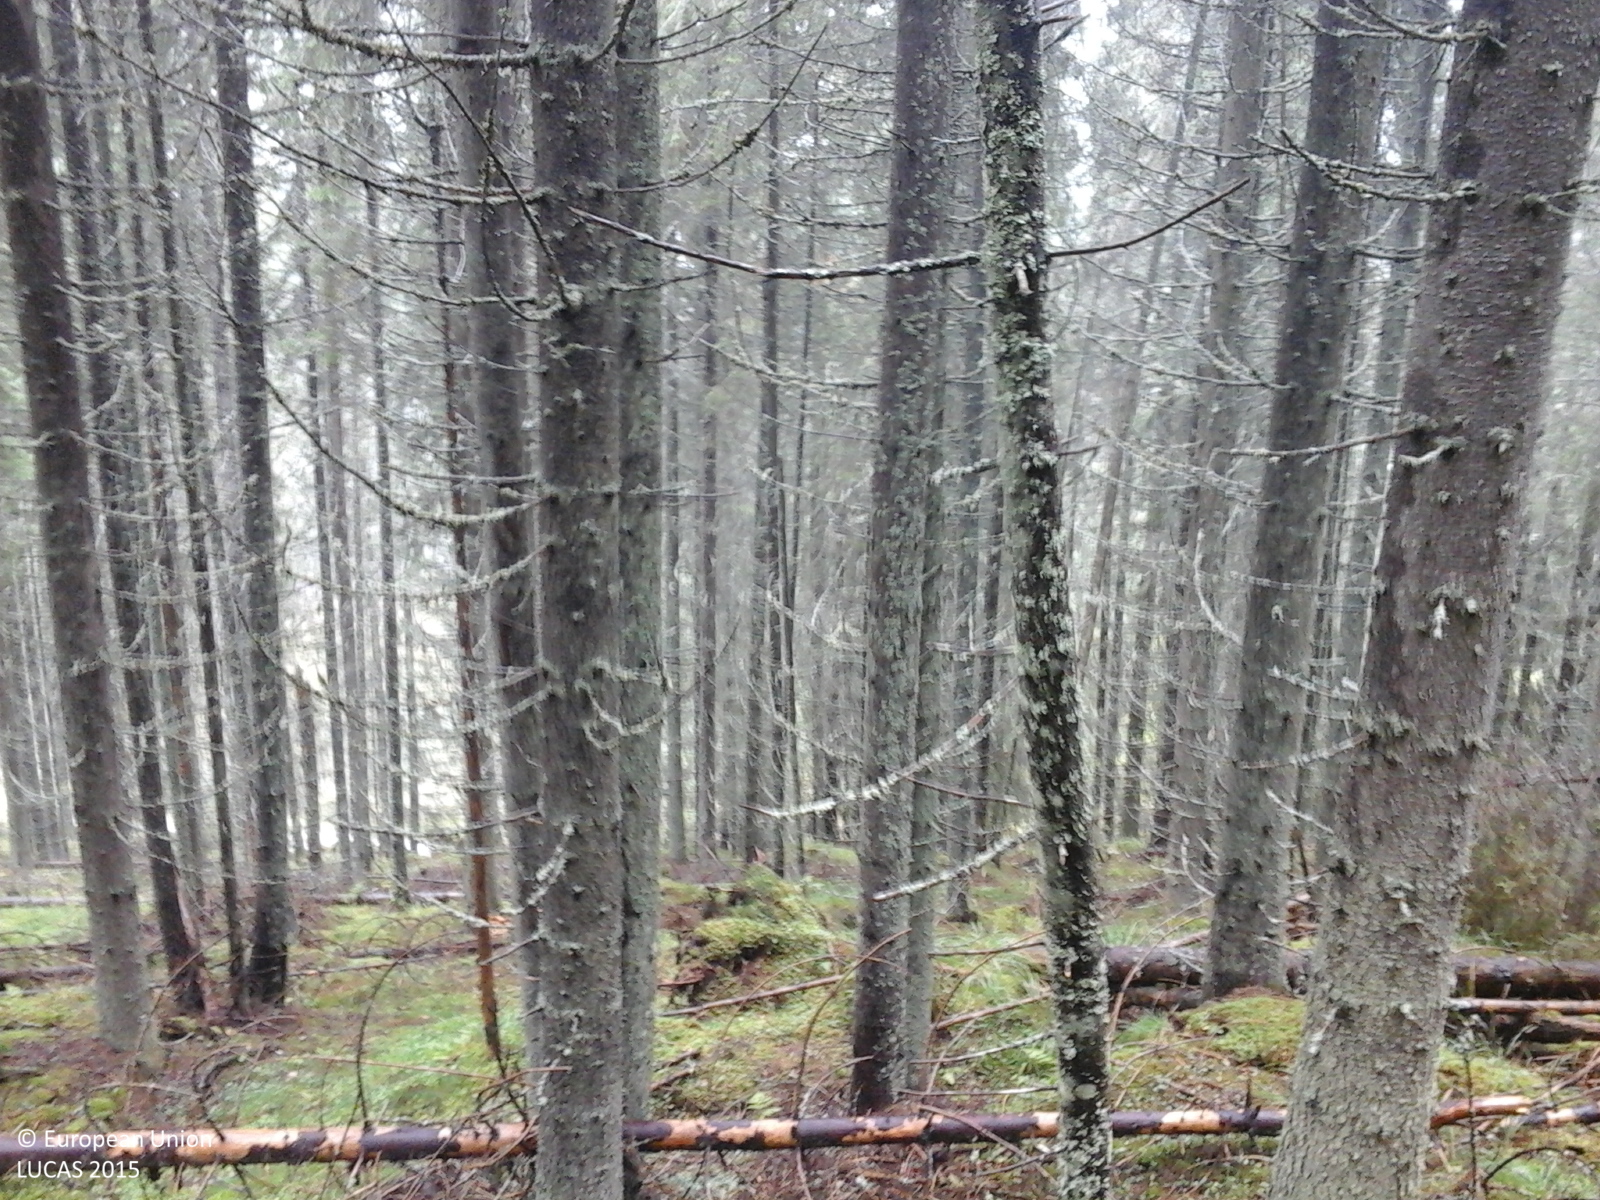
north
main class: Woodland
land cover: Spruce dominated coniferous woodland
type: alpine coniferous forest
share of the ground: > 75 %
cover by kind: coniferous forest trees 100 %
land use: Forestry
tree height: > 5 m
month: September
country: RO
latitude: 45.5969
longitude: 23.6662
